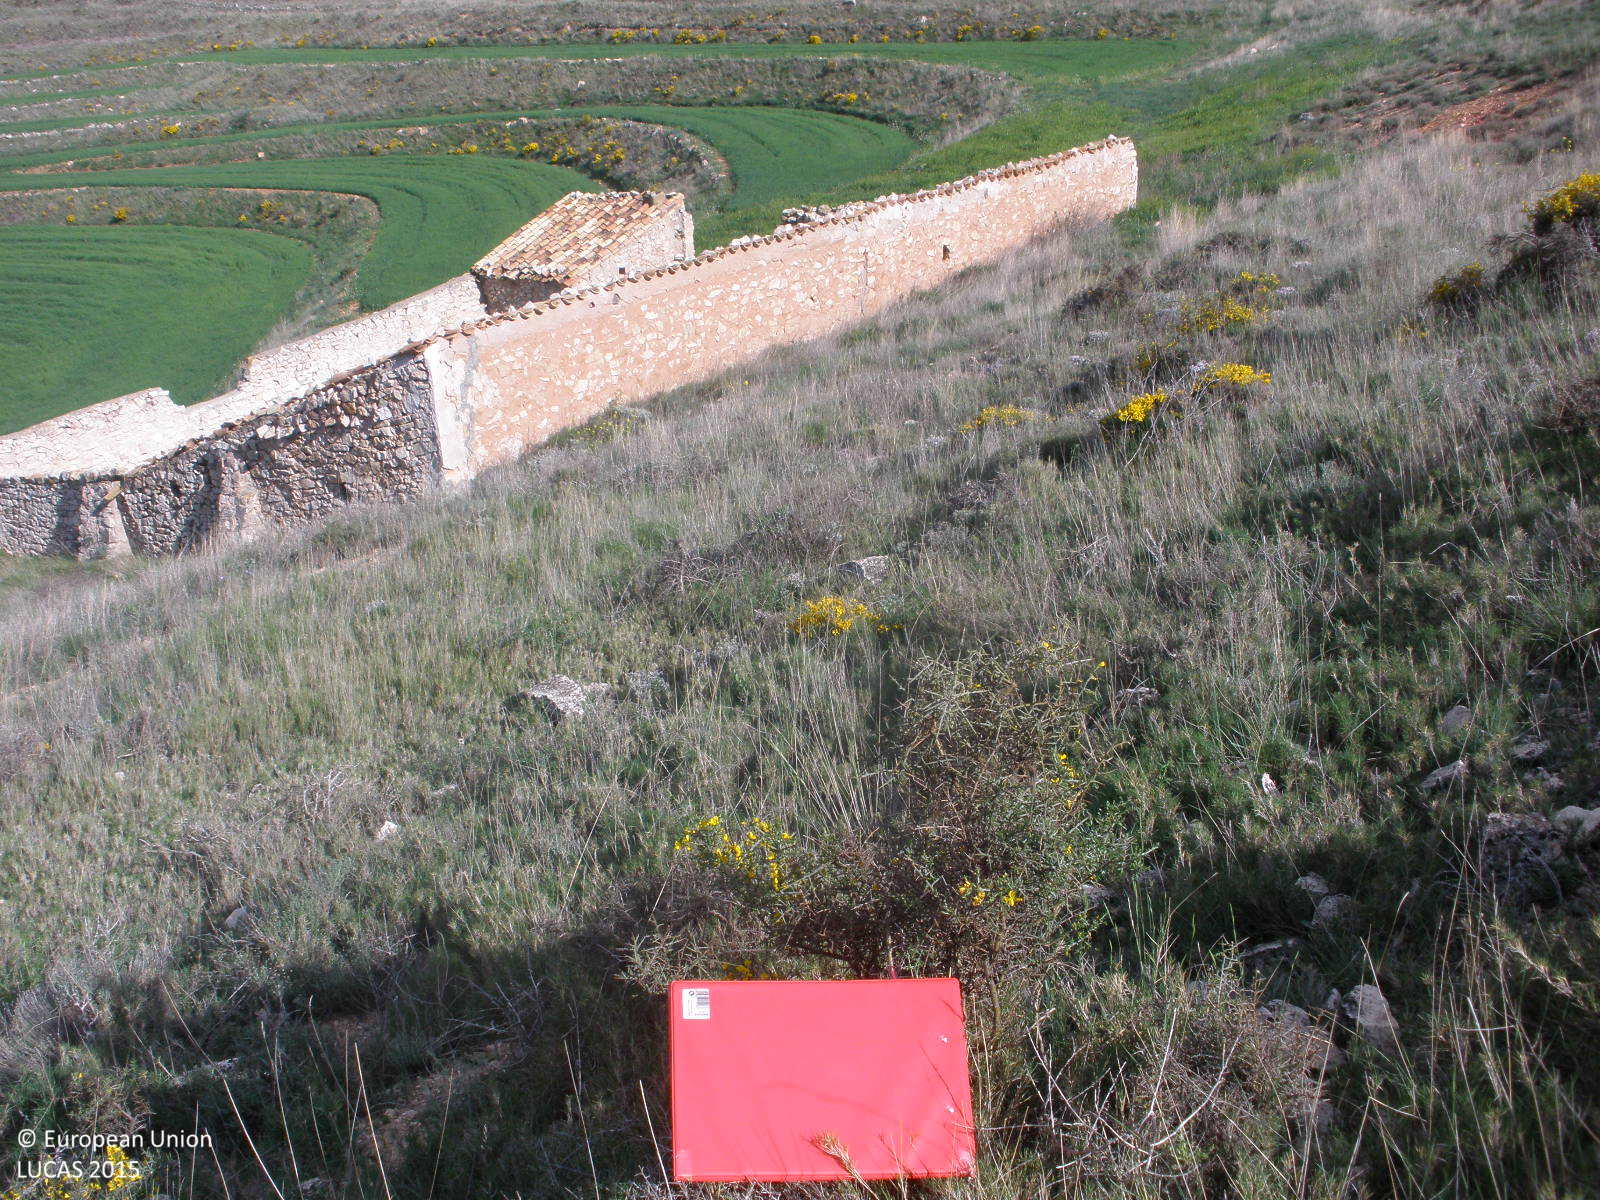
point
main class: Shrubland
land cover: Shrubland without tree cover
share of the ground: 50 - 75 %
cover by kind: shrubs 50 %, herbaceous plants 50 %
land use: Semi-natural and natural areas not in use
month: May
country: ES
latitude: 41.0590
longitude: -0.9280
